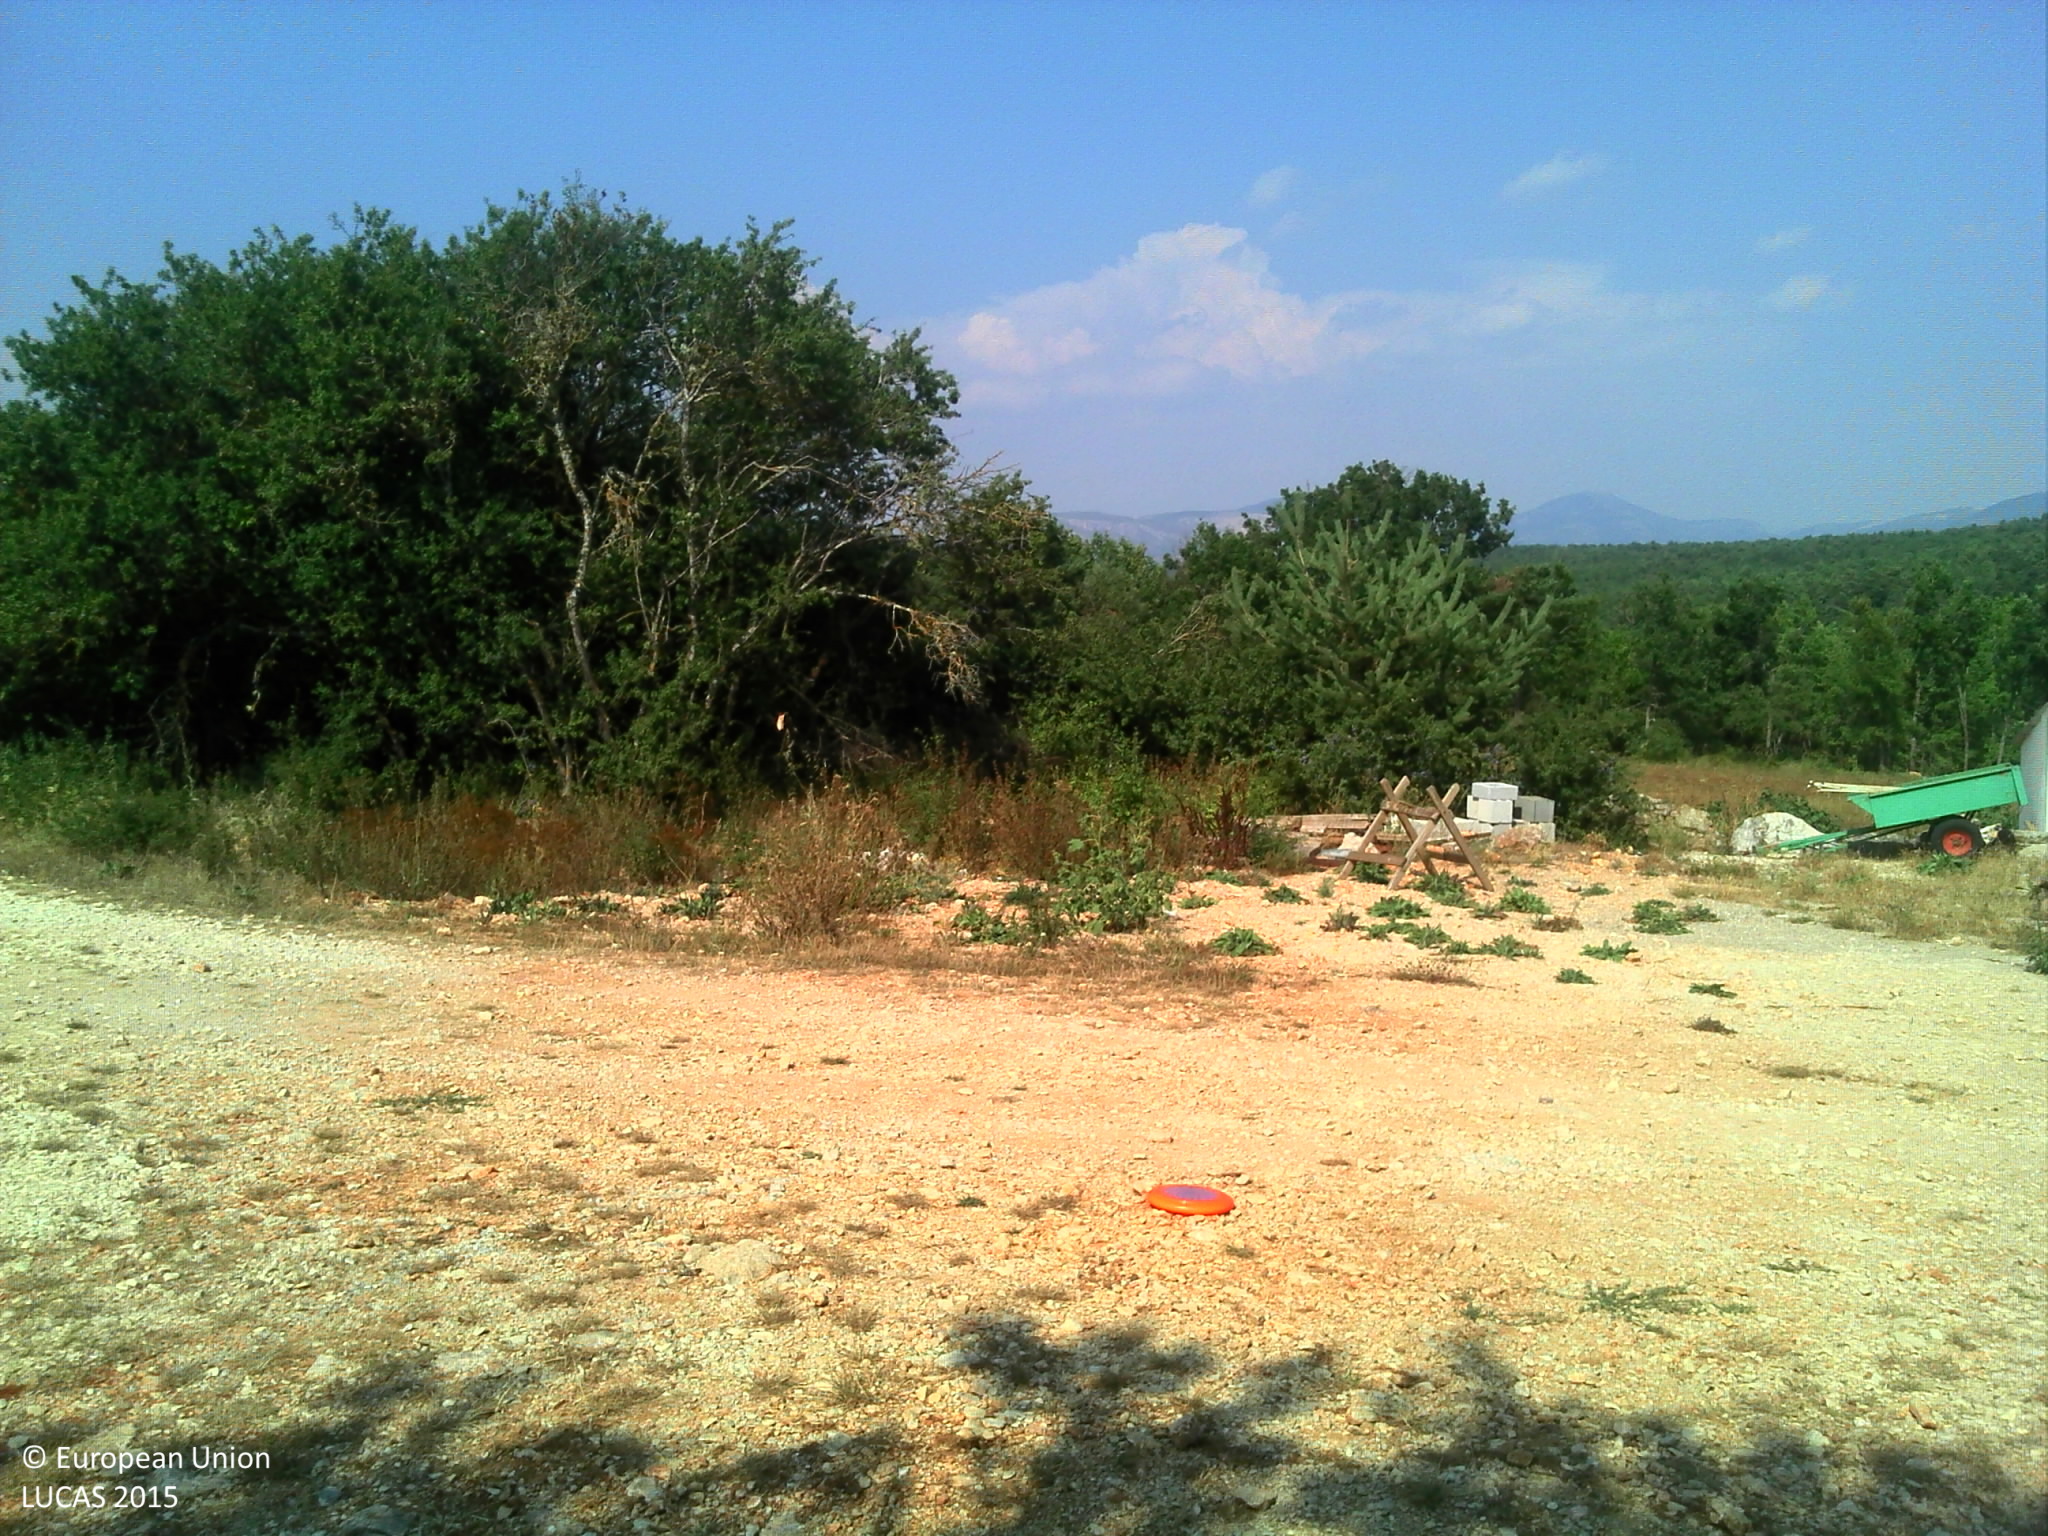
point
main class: Shrubland
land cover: Shrubland with sparse tree cover
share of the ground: > 75 %
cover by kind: shrubs 40 %, herbaceous plants 40 %, unconsolidated bare surface 15 %, broadleaved forest trees 5 %
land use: Community services
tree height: < 5 m
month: August
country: FR
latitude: 43.6587
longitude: 6.4742
